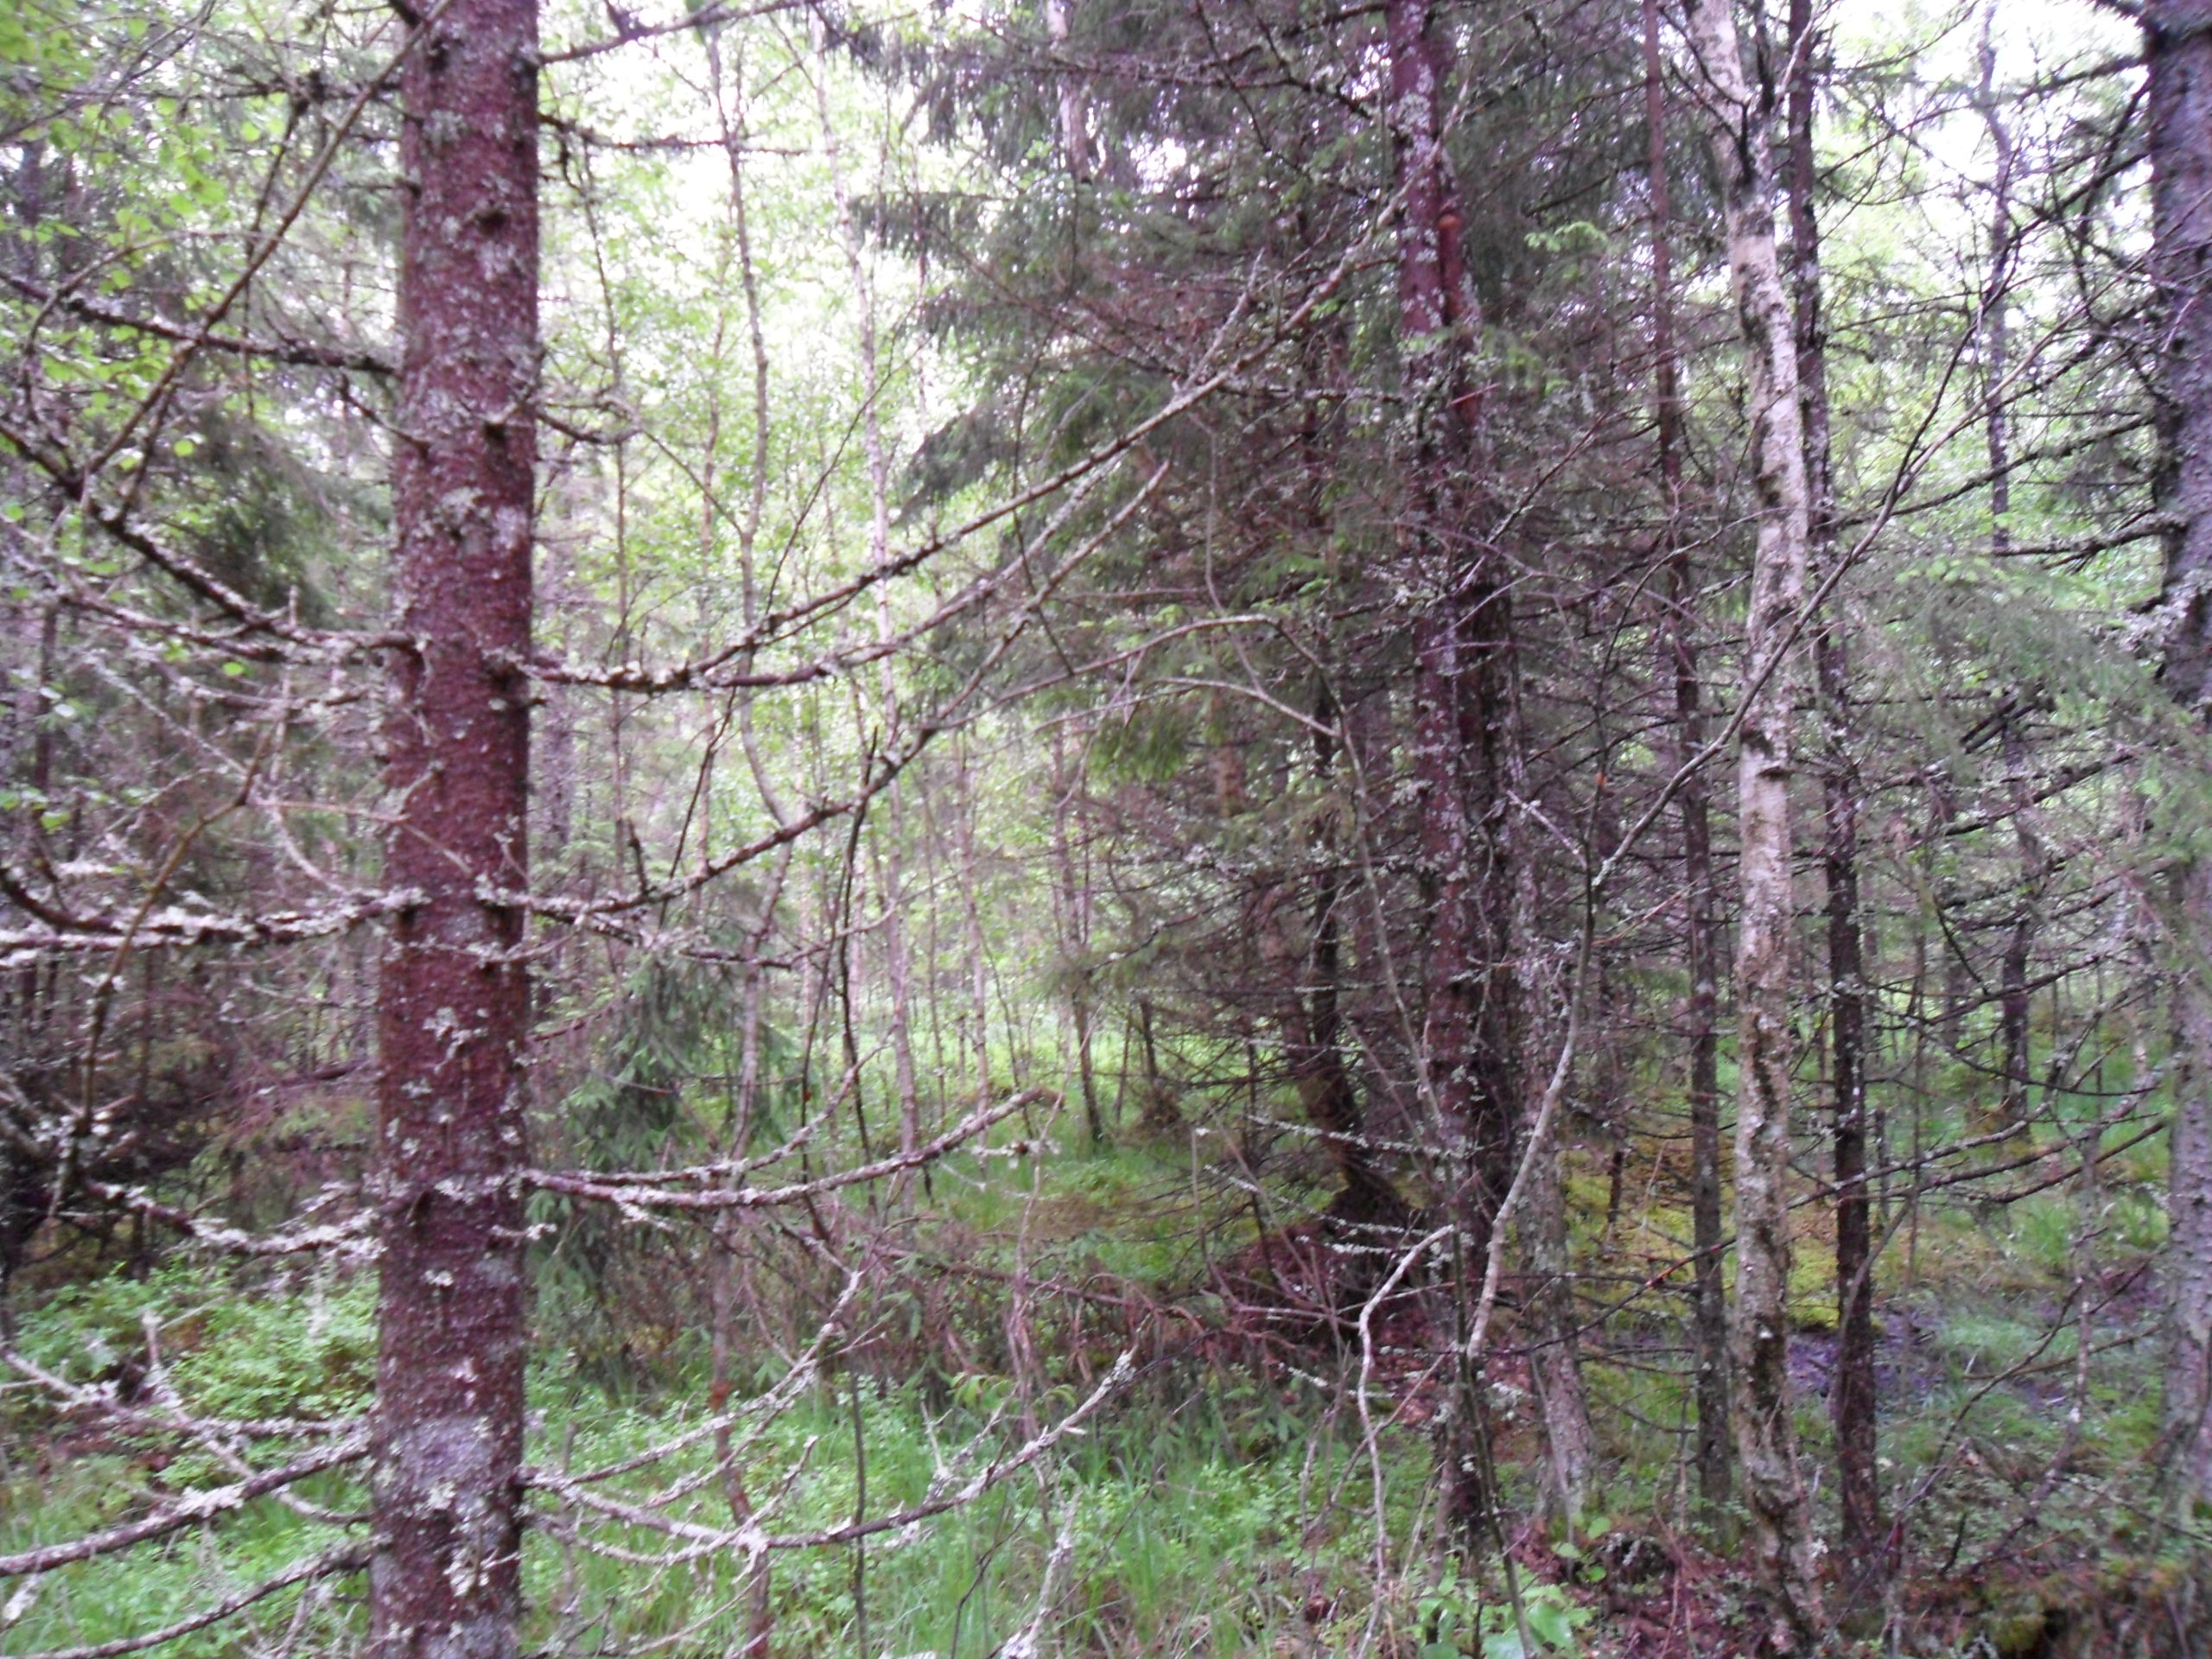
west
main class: Woodland
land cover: Spruce dominated mixed woodland
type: hemiboreal forest and nemoral coniferous forest and mixed broadleaved-coniferous forest
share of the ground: > 75 %
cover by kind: coniferous forest trees 50 %, broadleaved forest trees 30 %, herbaceous plants 20 %
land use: Forestry
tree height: > 5 m
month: June
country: LV
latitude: 57.4077
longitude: 22.1826
